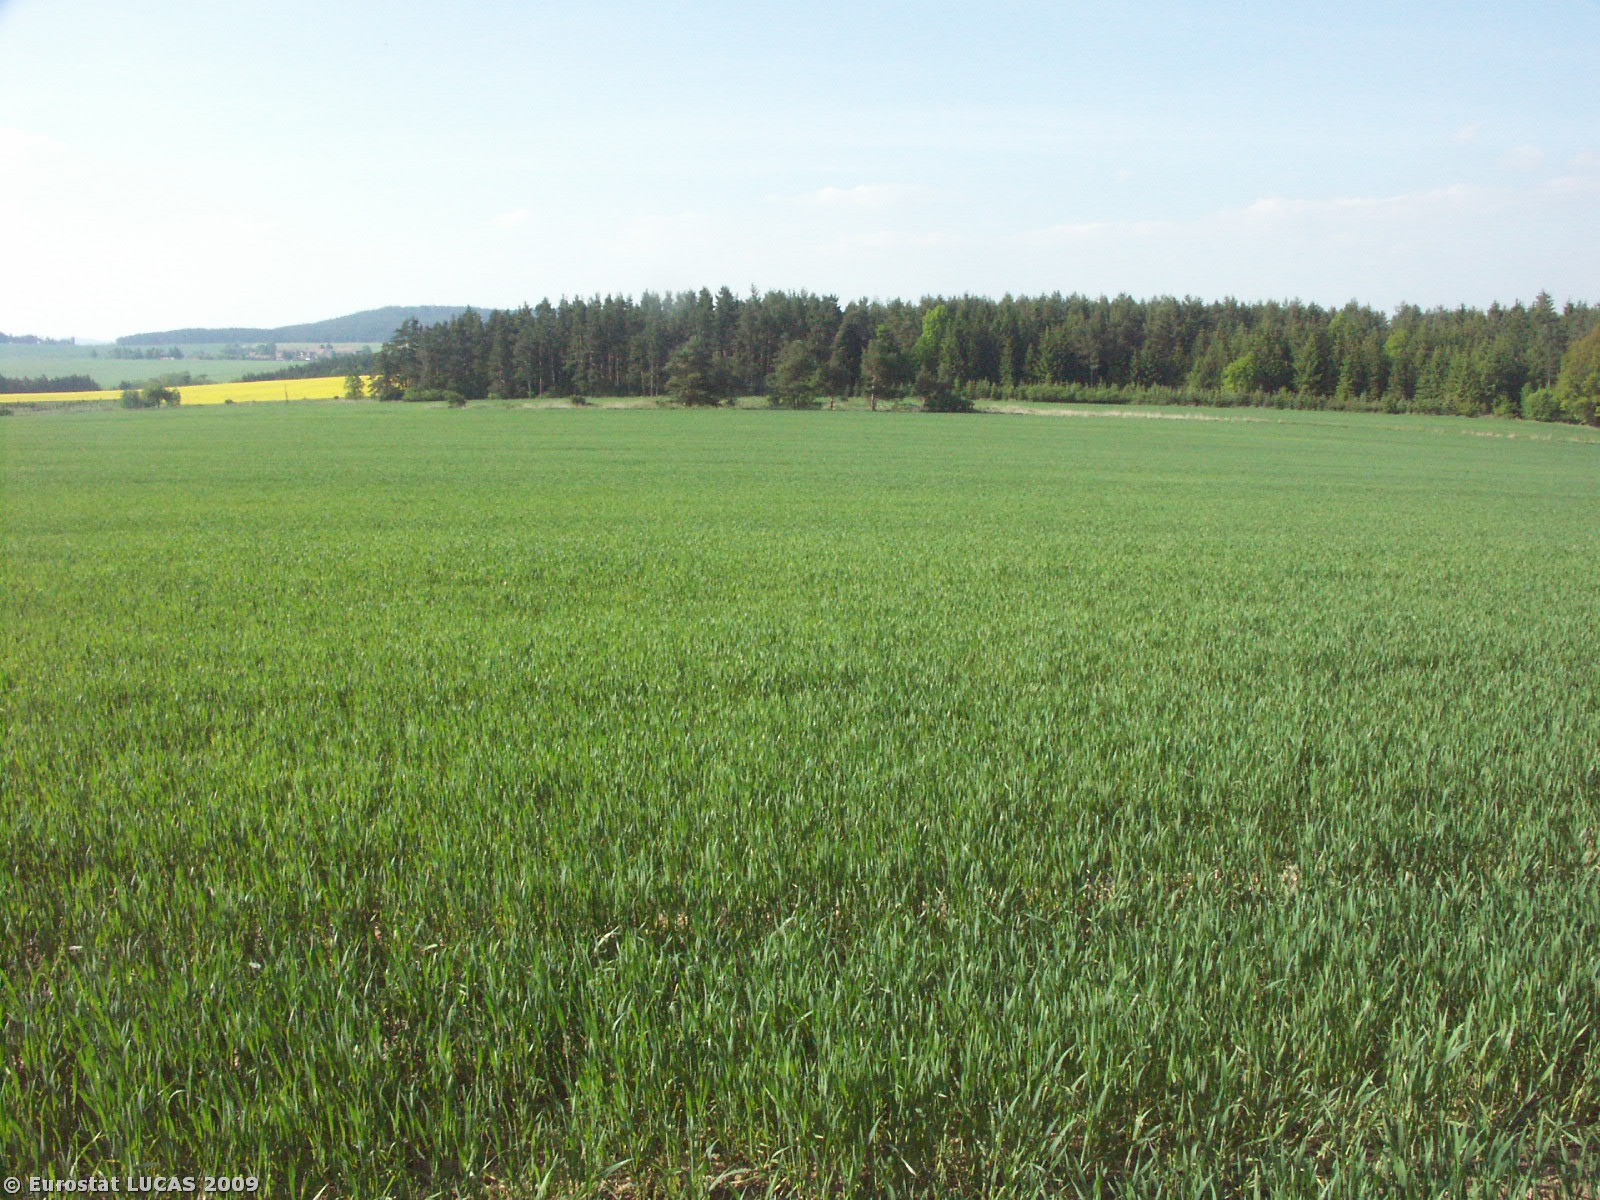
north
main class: Cropland
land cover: Common wheat
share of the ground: > 75 %
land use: Agriculture (excluding fallow land and kitchen gardens)
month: May
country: CZ
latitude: 49.0093
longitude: 15.4307
